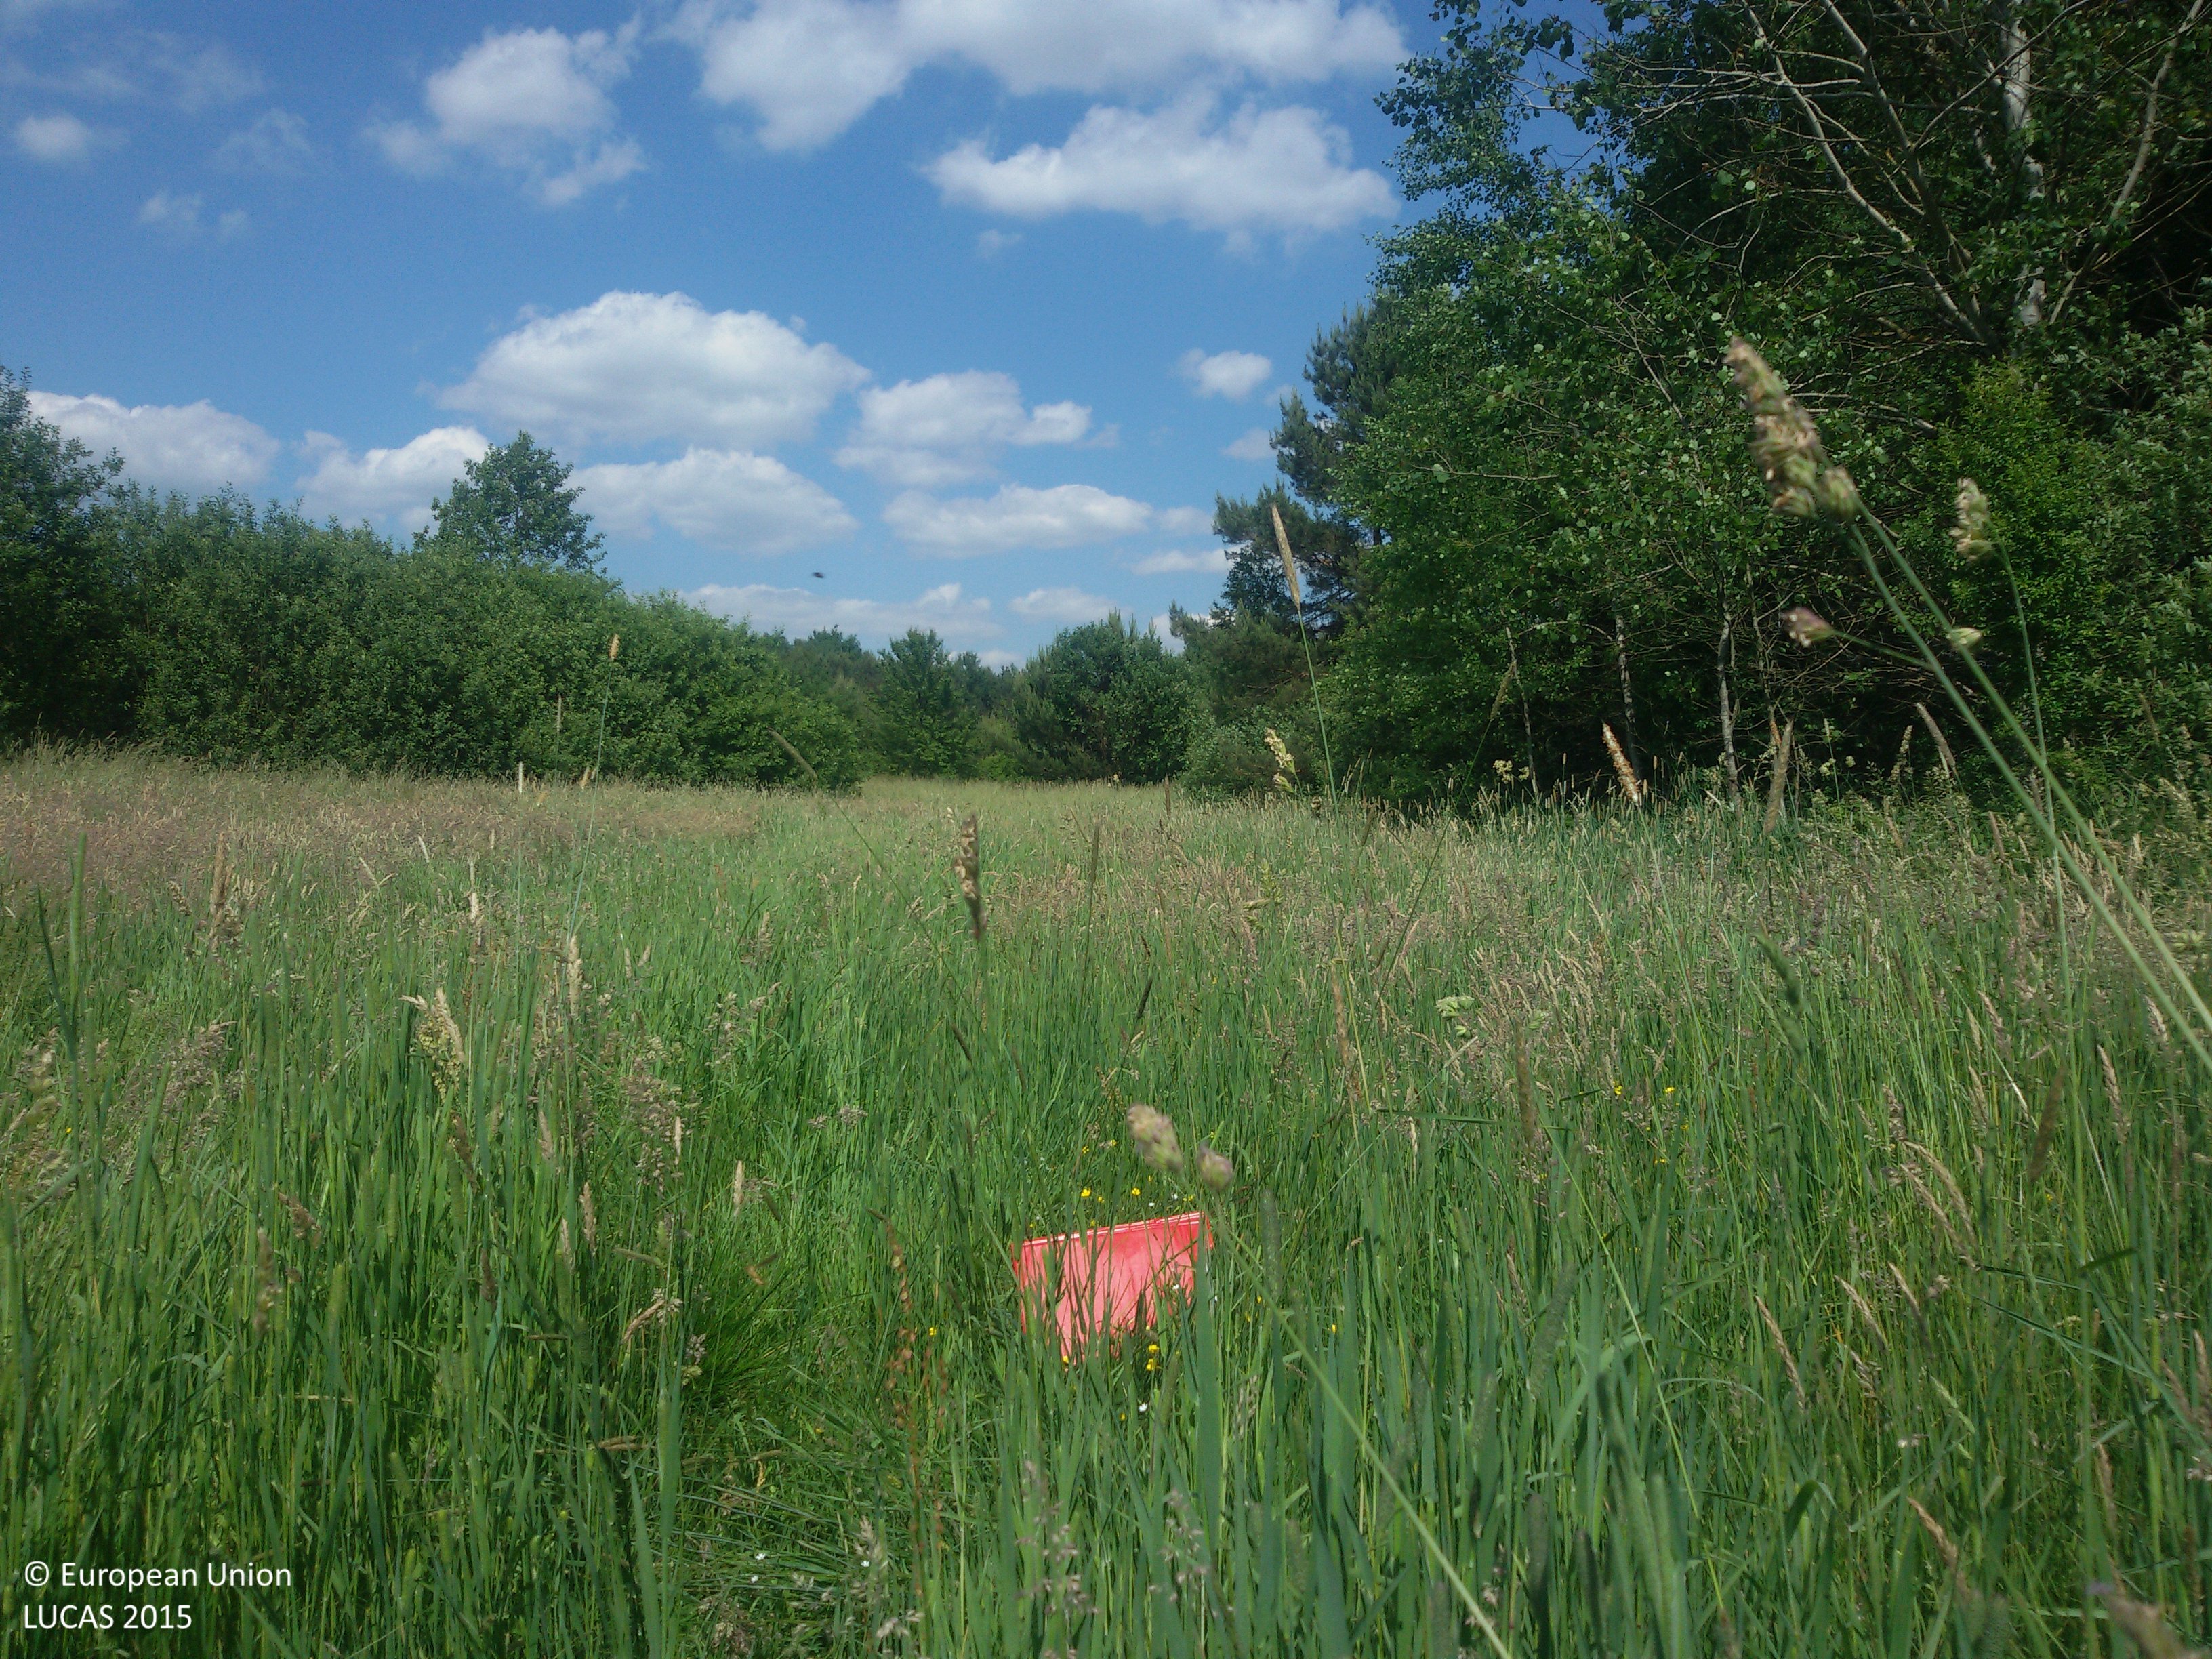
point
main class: Grassland
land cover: Grassland without tree/shrub cover
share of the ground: > 75 %
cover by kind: herbaceous plants 100 %
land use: Agriculture (excluding fallow land and kitchen gardens)
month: June
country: PL
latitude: 51.5703
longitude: 22.8115
